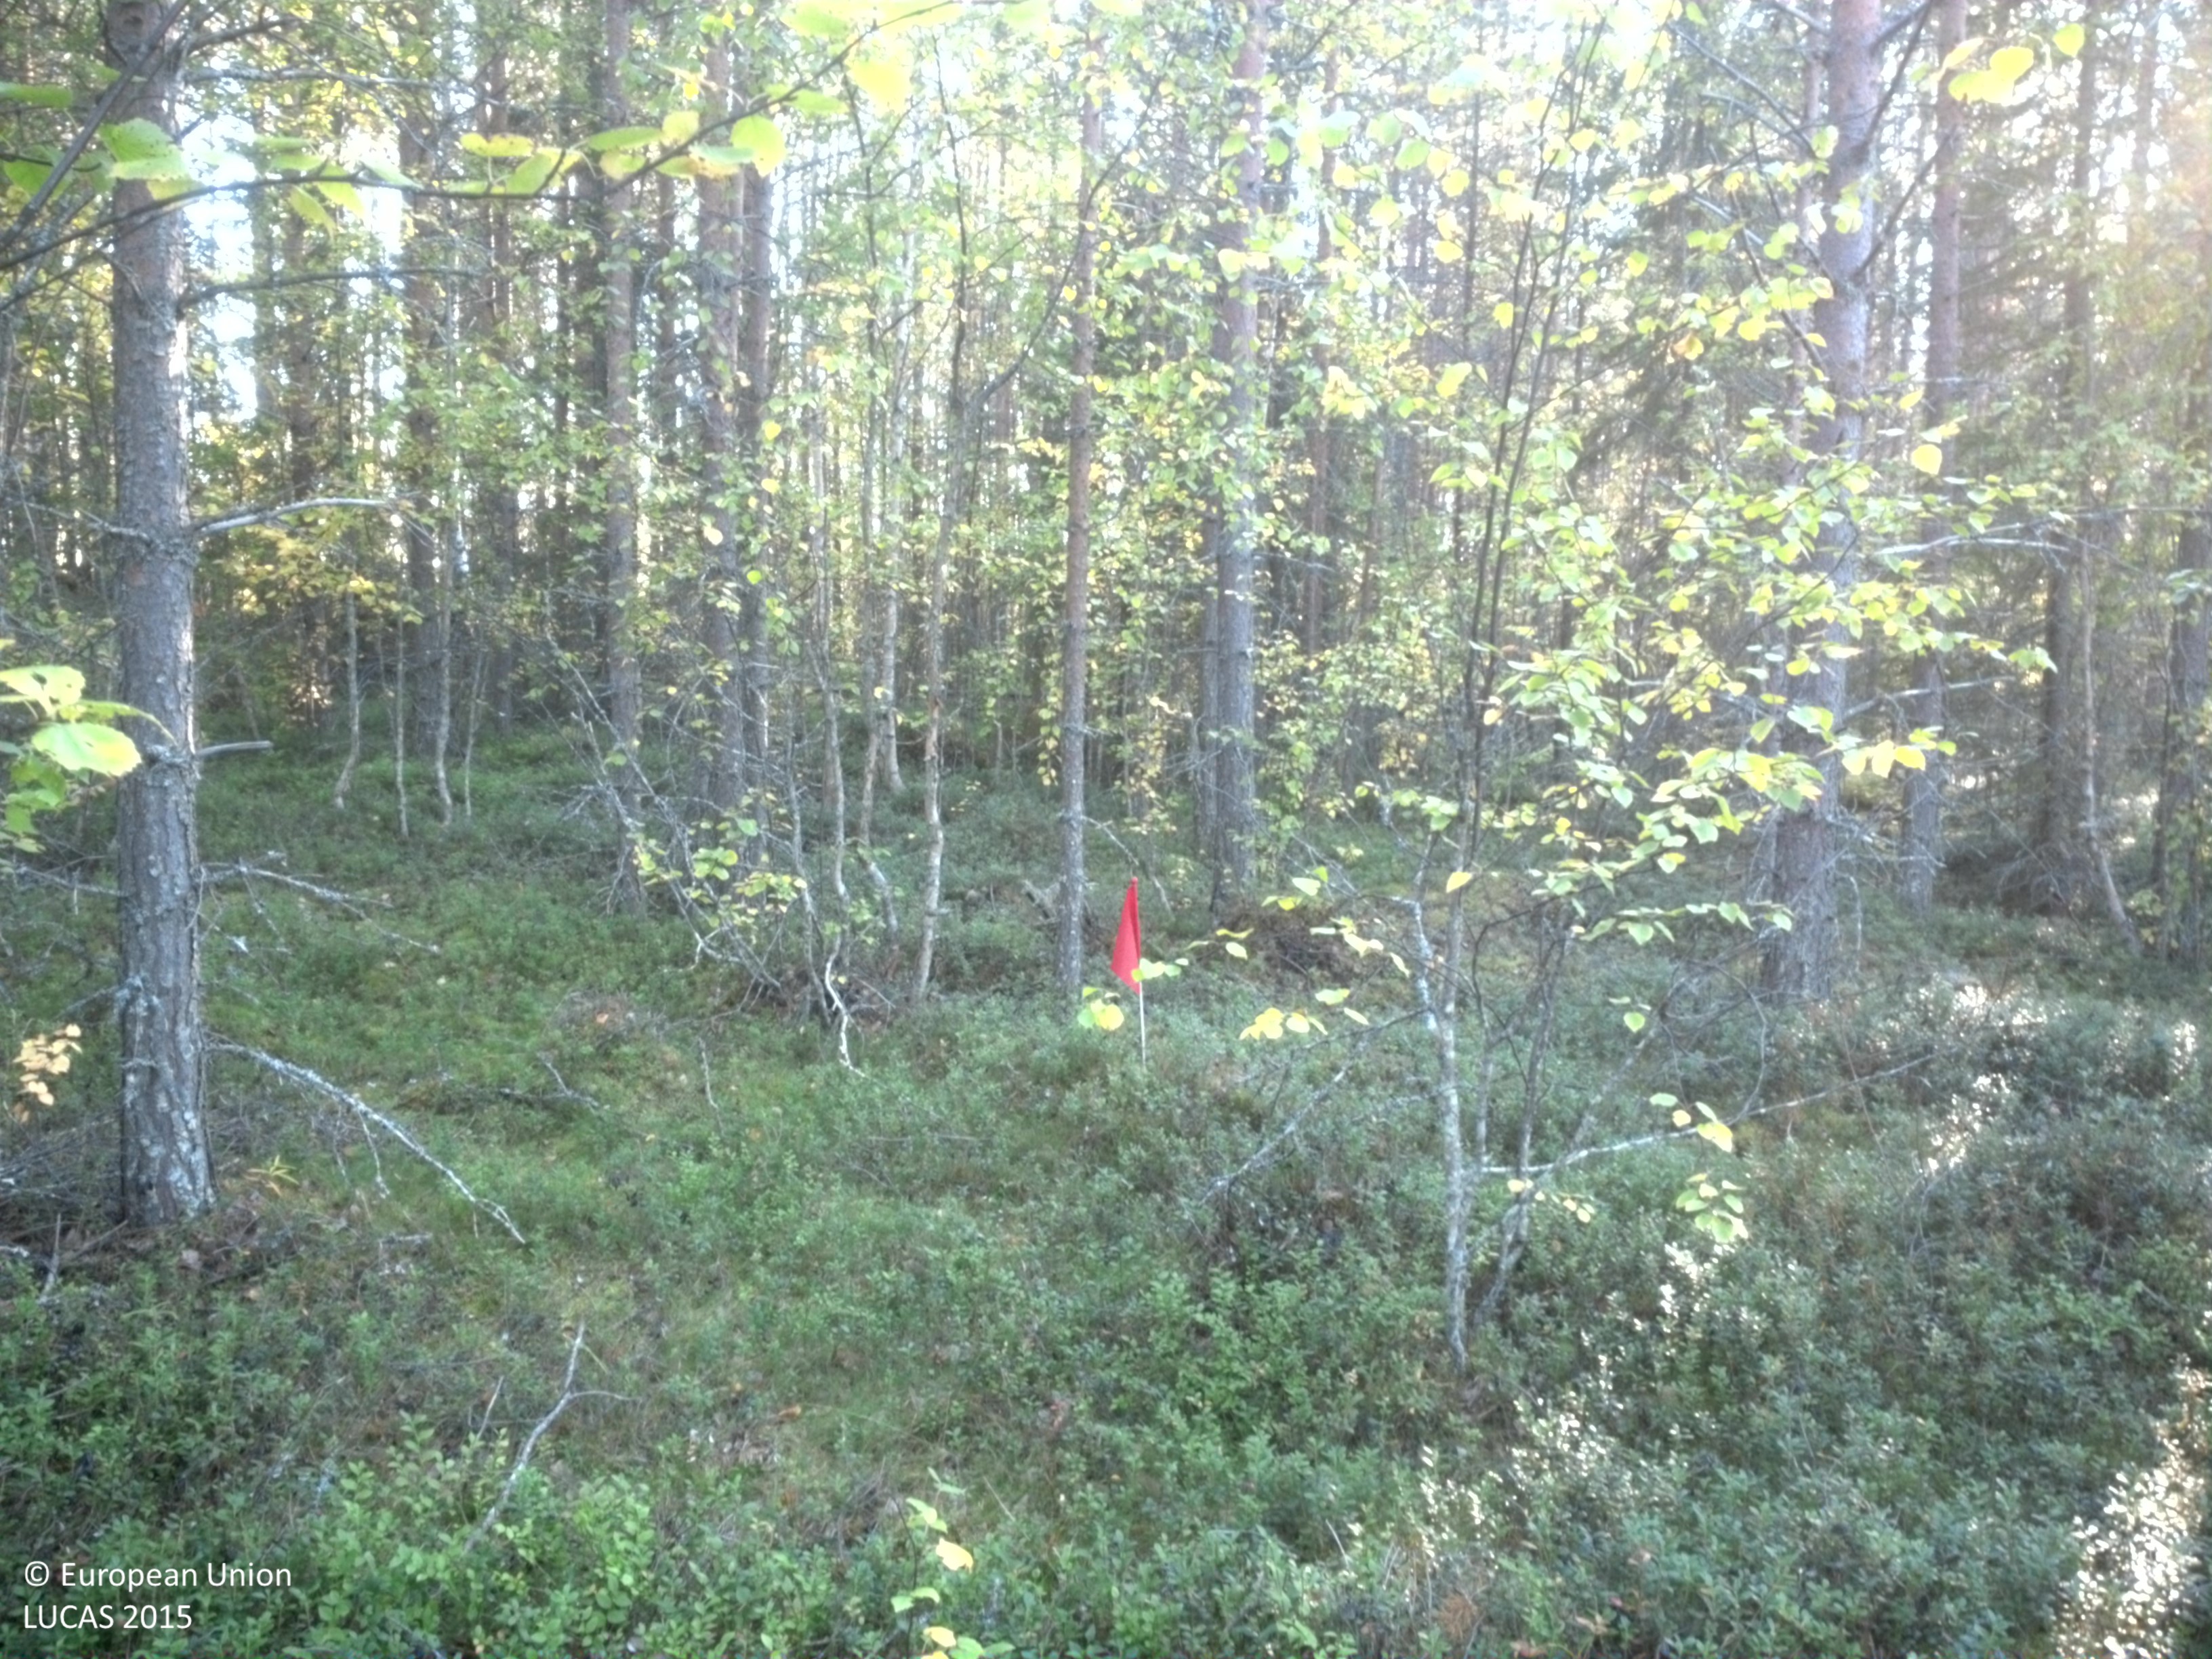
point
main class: Woodland
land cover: Pine dominated mixed woodland
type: boreal forest
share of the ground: 50 - 75 %
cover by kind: coniferous forest trees 45 %, shrubs 30 %, broadleaved forest trees 15 %, lichens and mosses 10 %
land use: Forestry
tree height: > 5 m
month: September
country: SE
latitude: 64.3719
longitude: 19.7337
